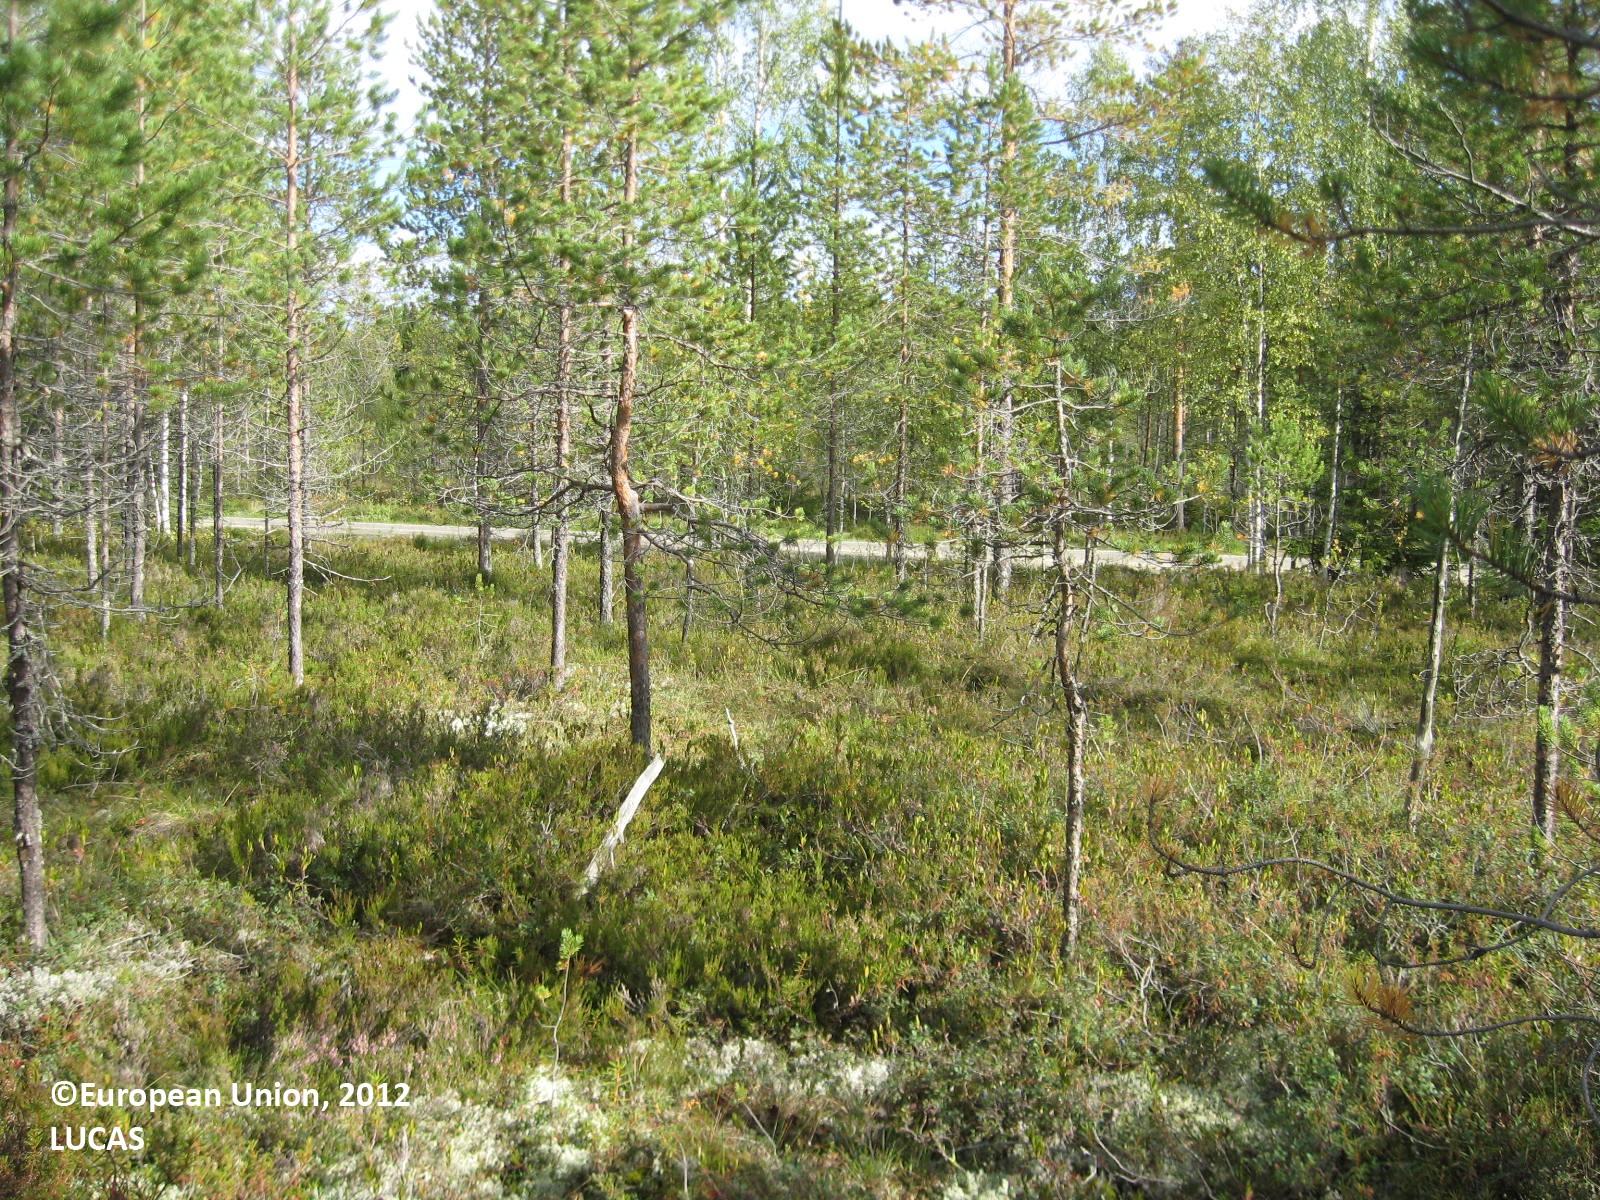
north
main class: Woodland
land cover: Pine dominated coniferous woodland
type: boreal forest
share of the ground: 25 - 50 %
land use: Forestry
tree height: > 5 m
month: August
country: FI
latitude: 63.5965
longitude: 29.5157
